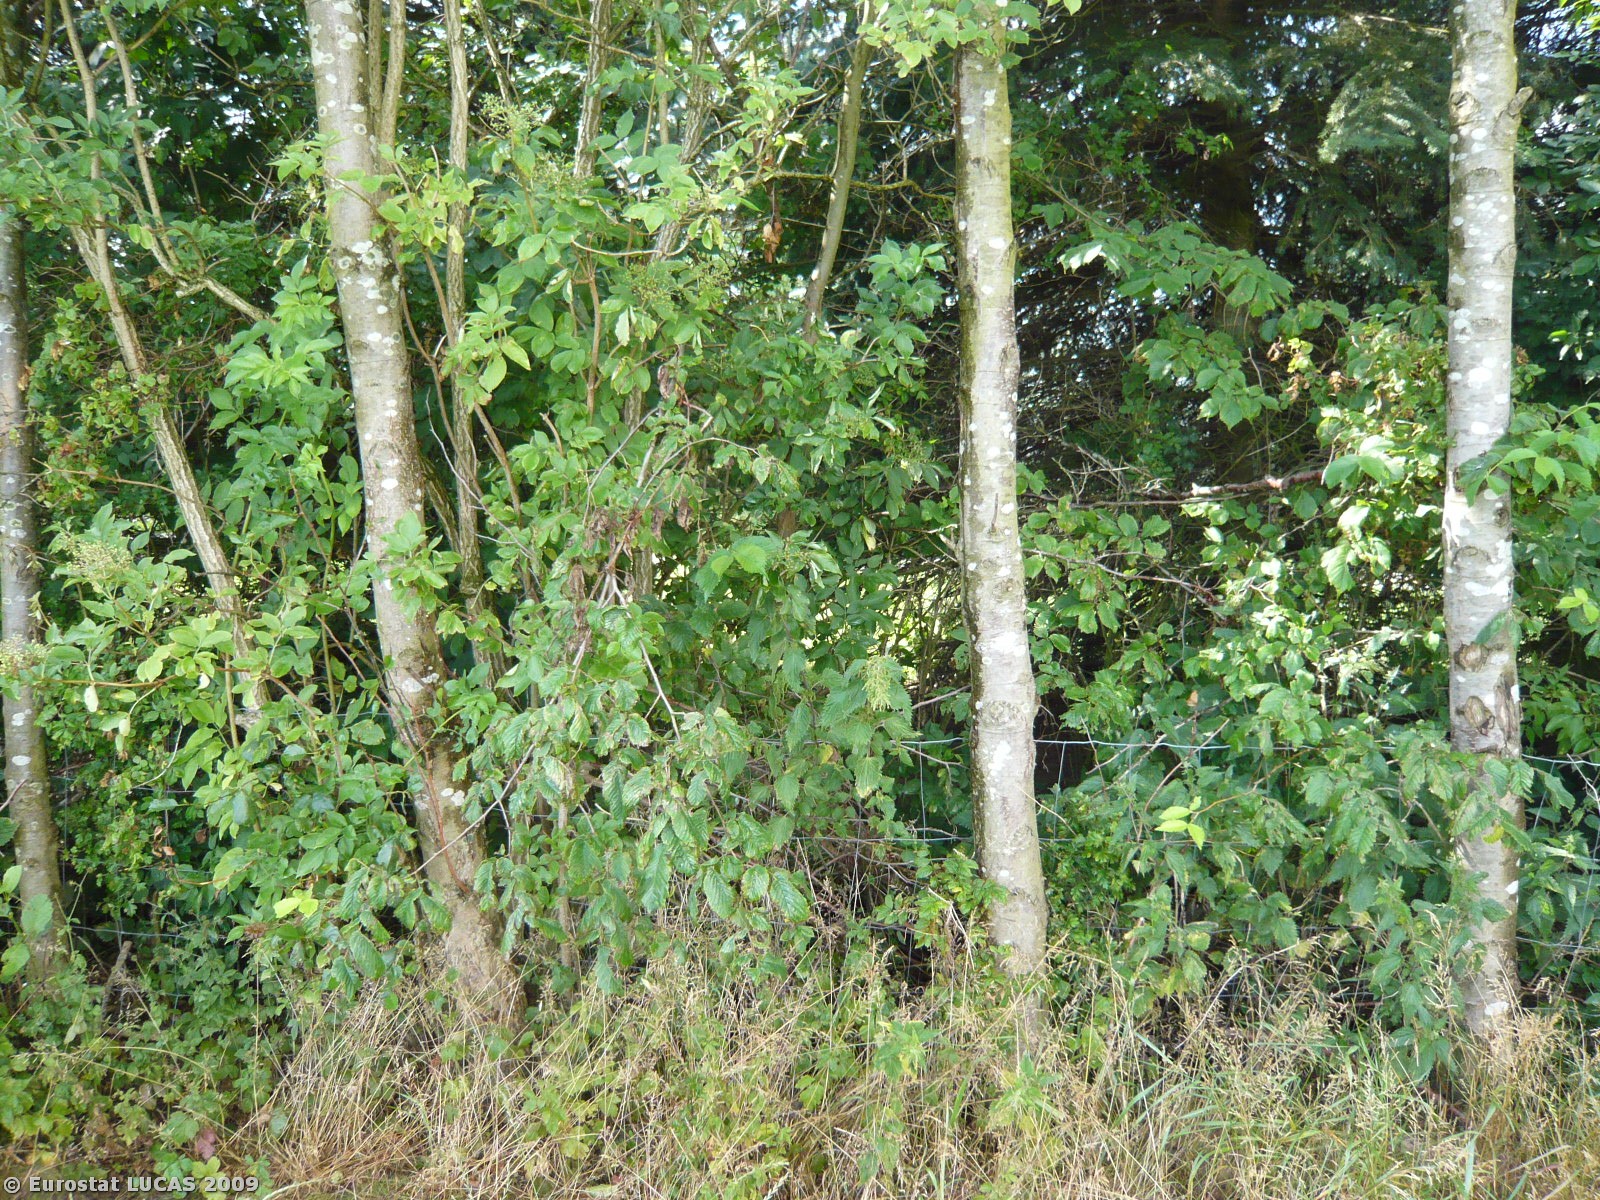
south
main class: Grassland
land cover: Grassland without tree/shrub cover
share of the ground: > 75 %
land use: Agriculture (excluding fallow land and kitchen gardens)
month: July
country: DK
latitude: 55.5956
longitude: 12.0771
